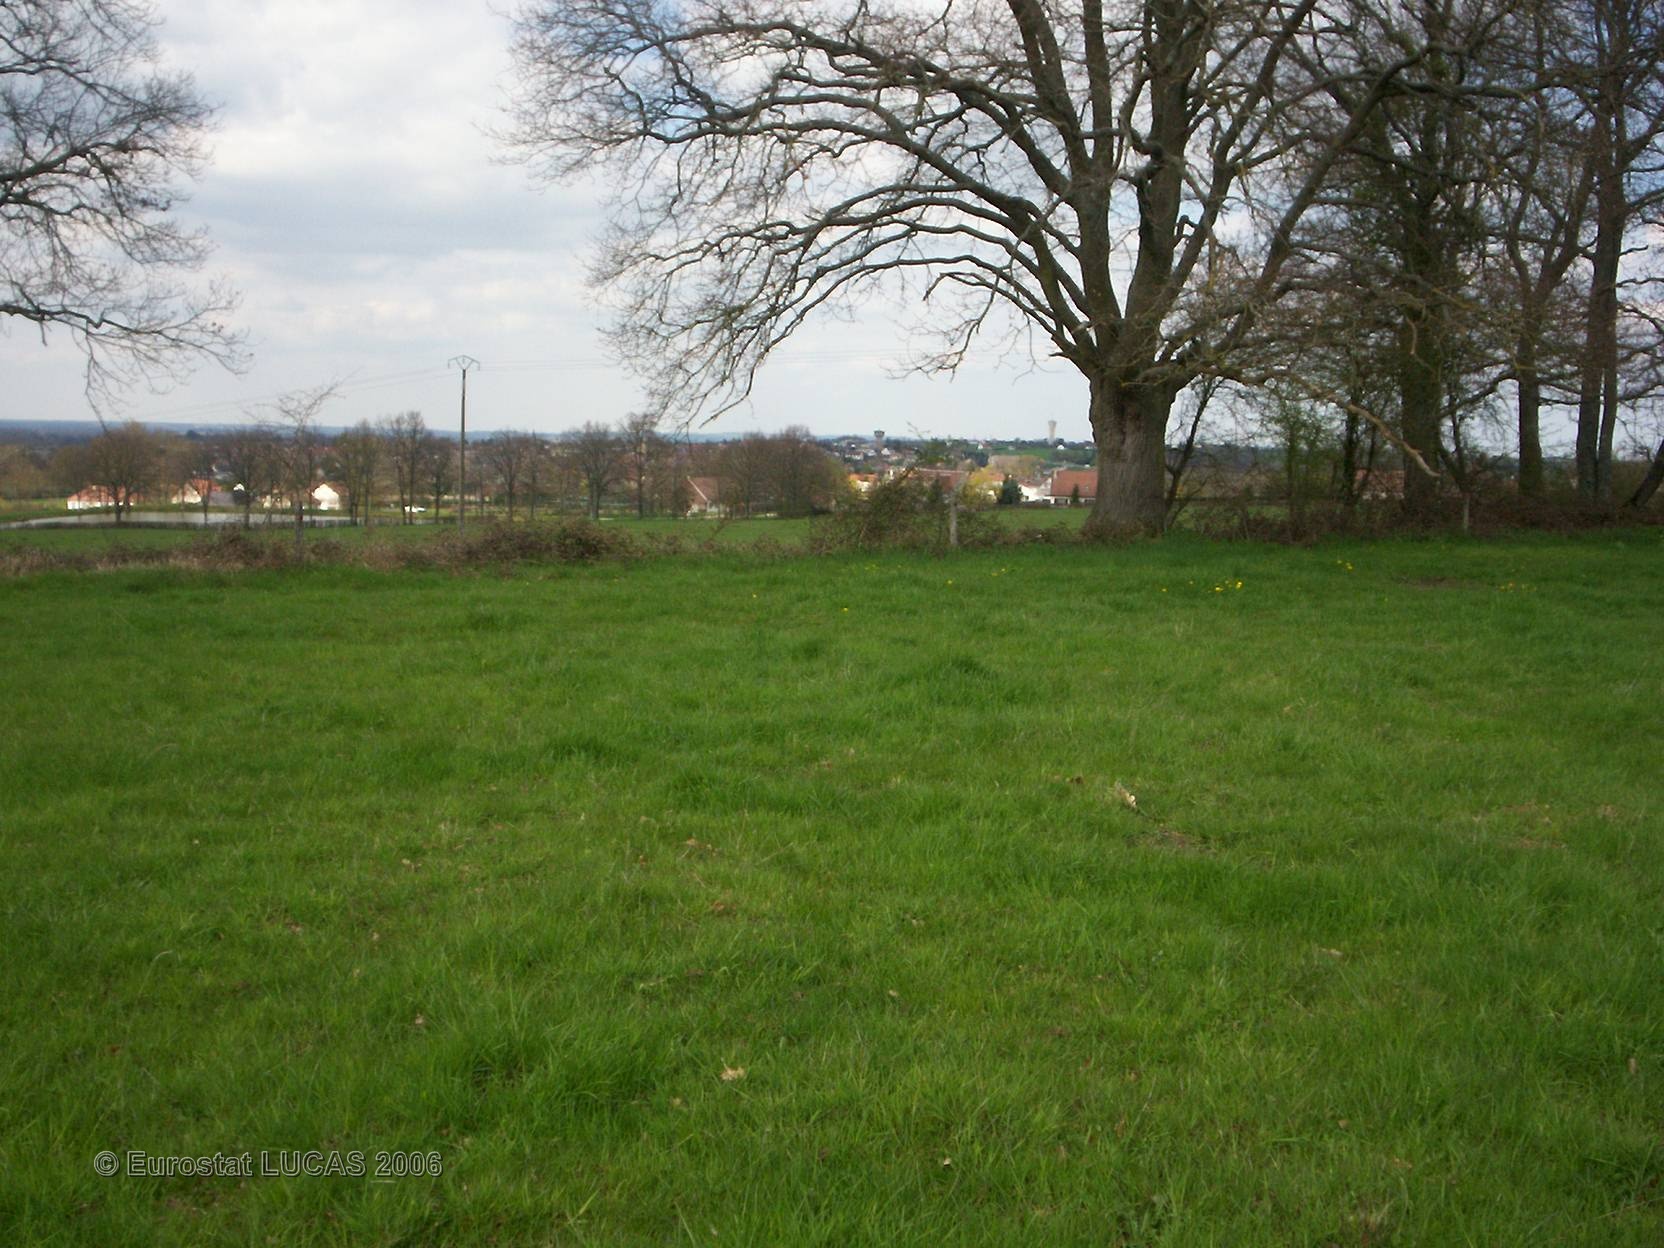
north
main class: Grassland
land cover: Grassland without tree/shrub cover
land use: Agriculture (excluding fallow land and kitchen gardens)
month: April
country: FR
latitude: 46.7802
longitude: 3.1205
